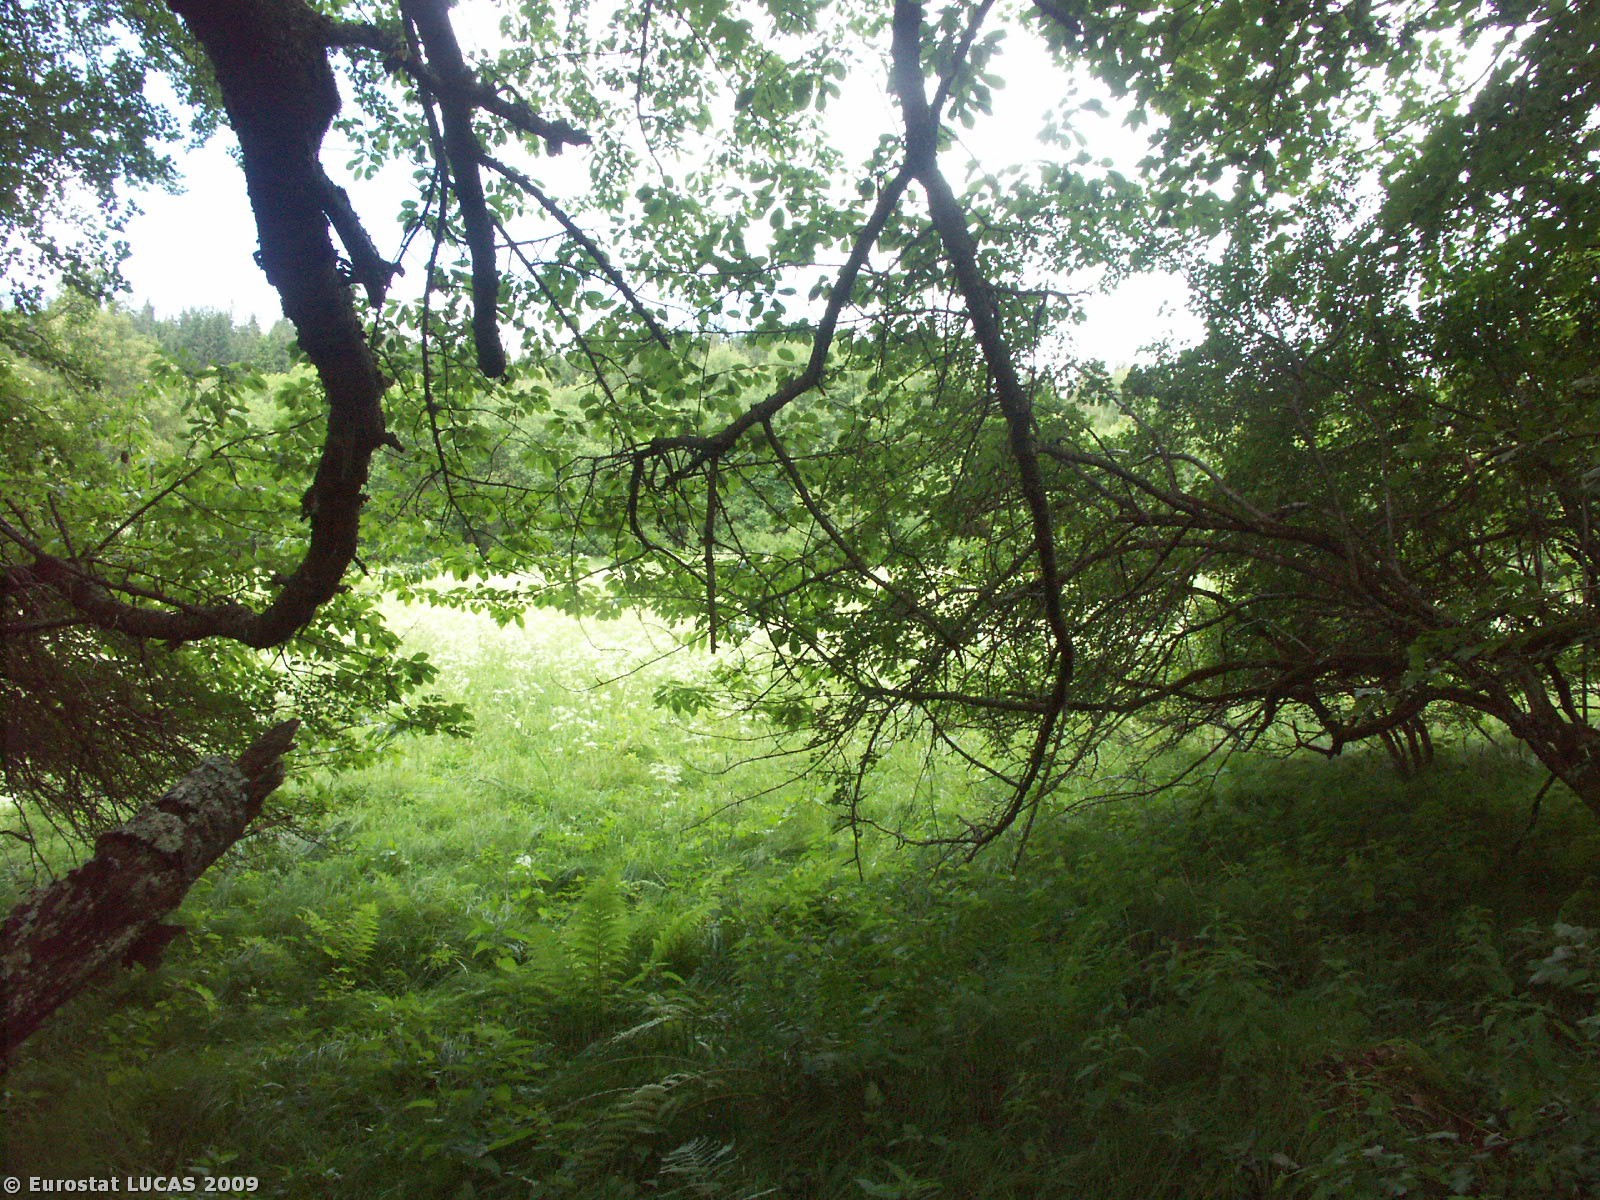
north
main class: Woodland
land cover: Broadleaved woodland
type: mesophytic deciduous forest
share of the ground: > 75 %
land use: Nature reserves
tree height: > 5 m
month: June
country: CZ
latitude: 48.6164
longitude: 14.0832
